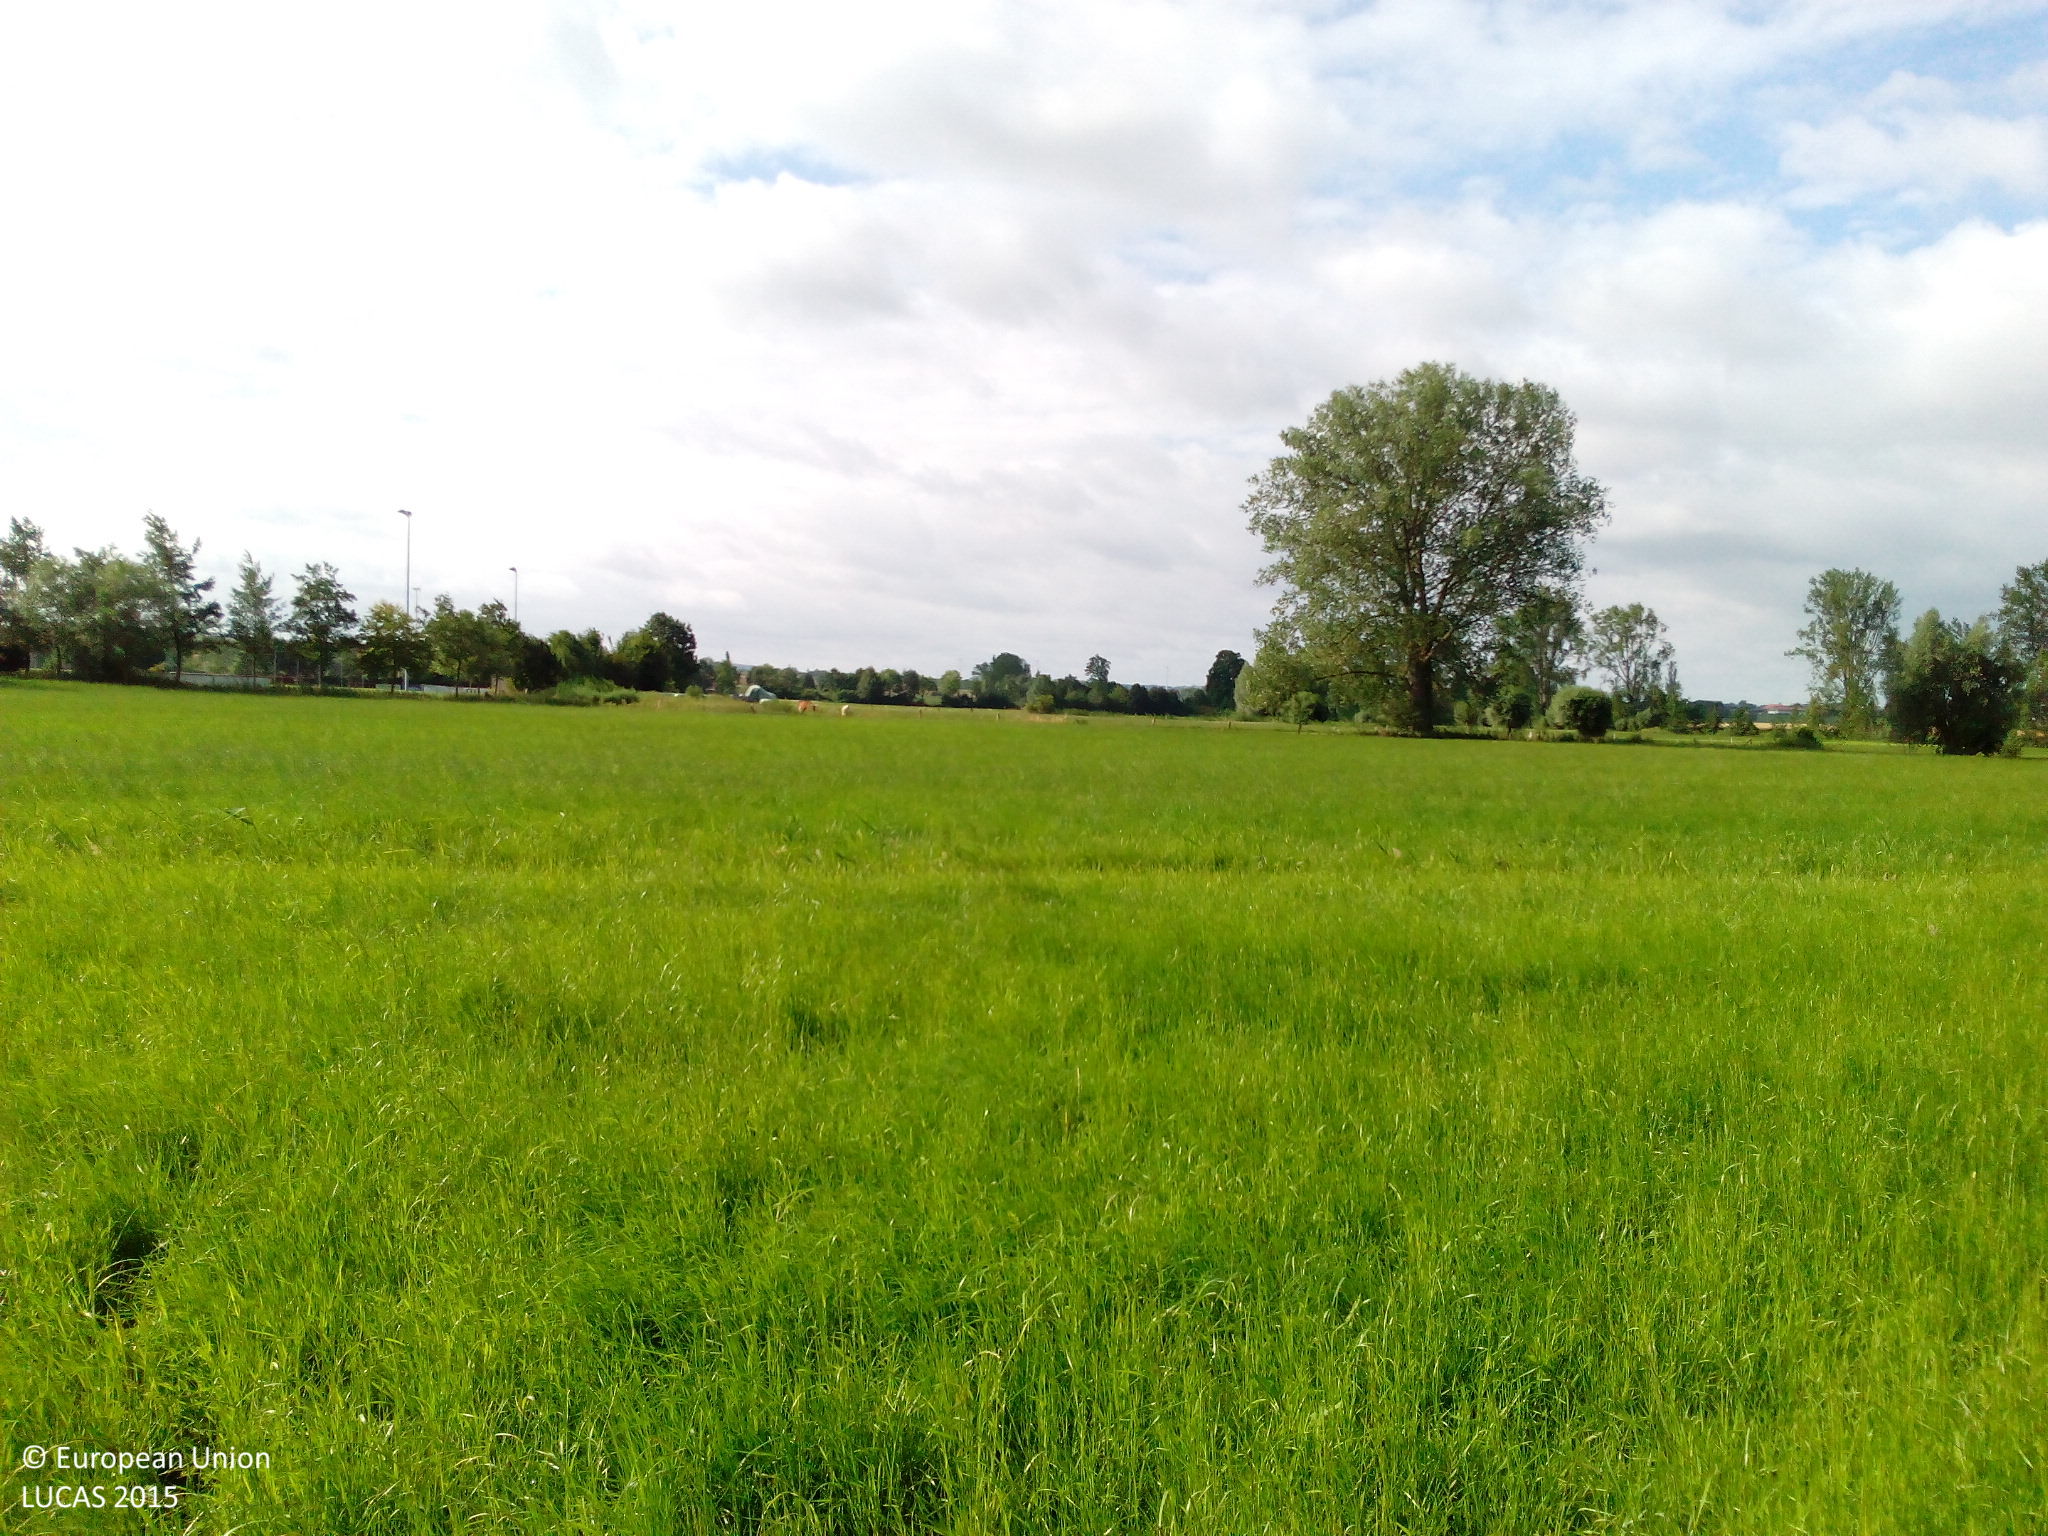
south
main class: Grassland
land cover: Grassland without tree/shrub cover
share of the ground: > 75 %
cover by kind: herbaceous plants 100 %
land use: Agriculture (excluding fallow land and kitchen gardens)
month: July
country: DE
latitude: 51.5301
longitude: 9.2362
